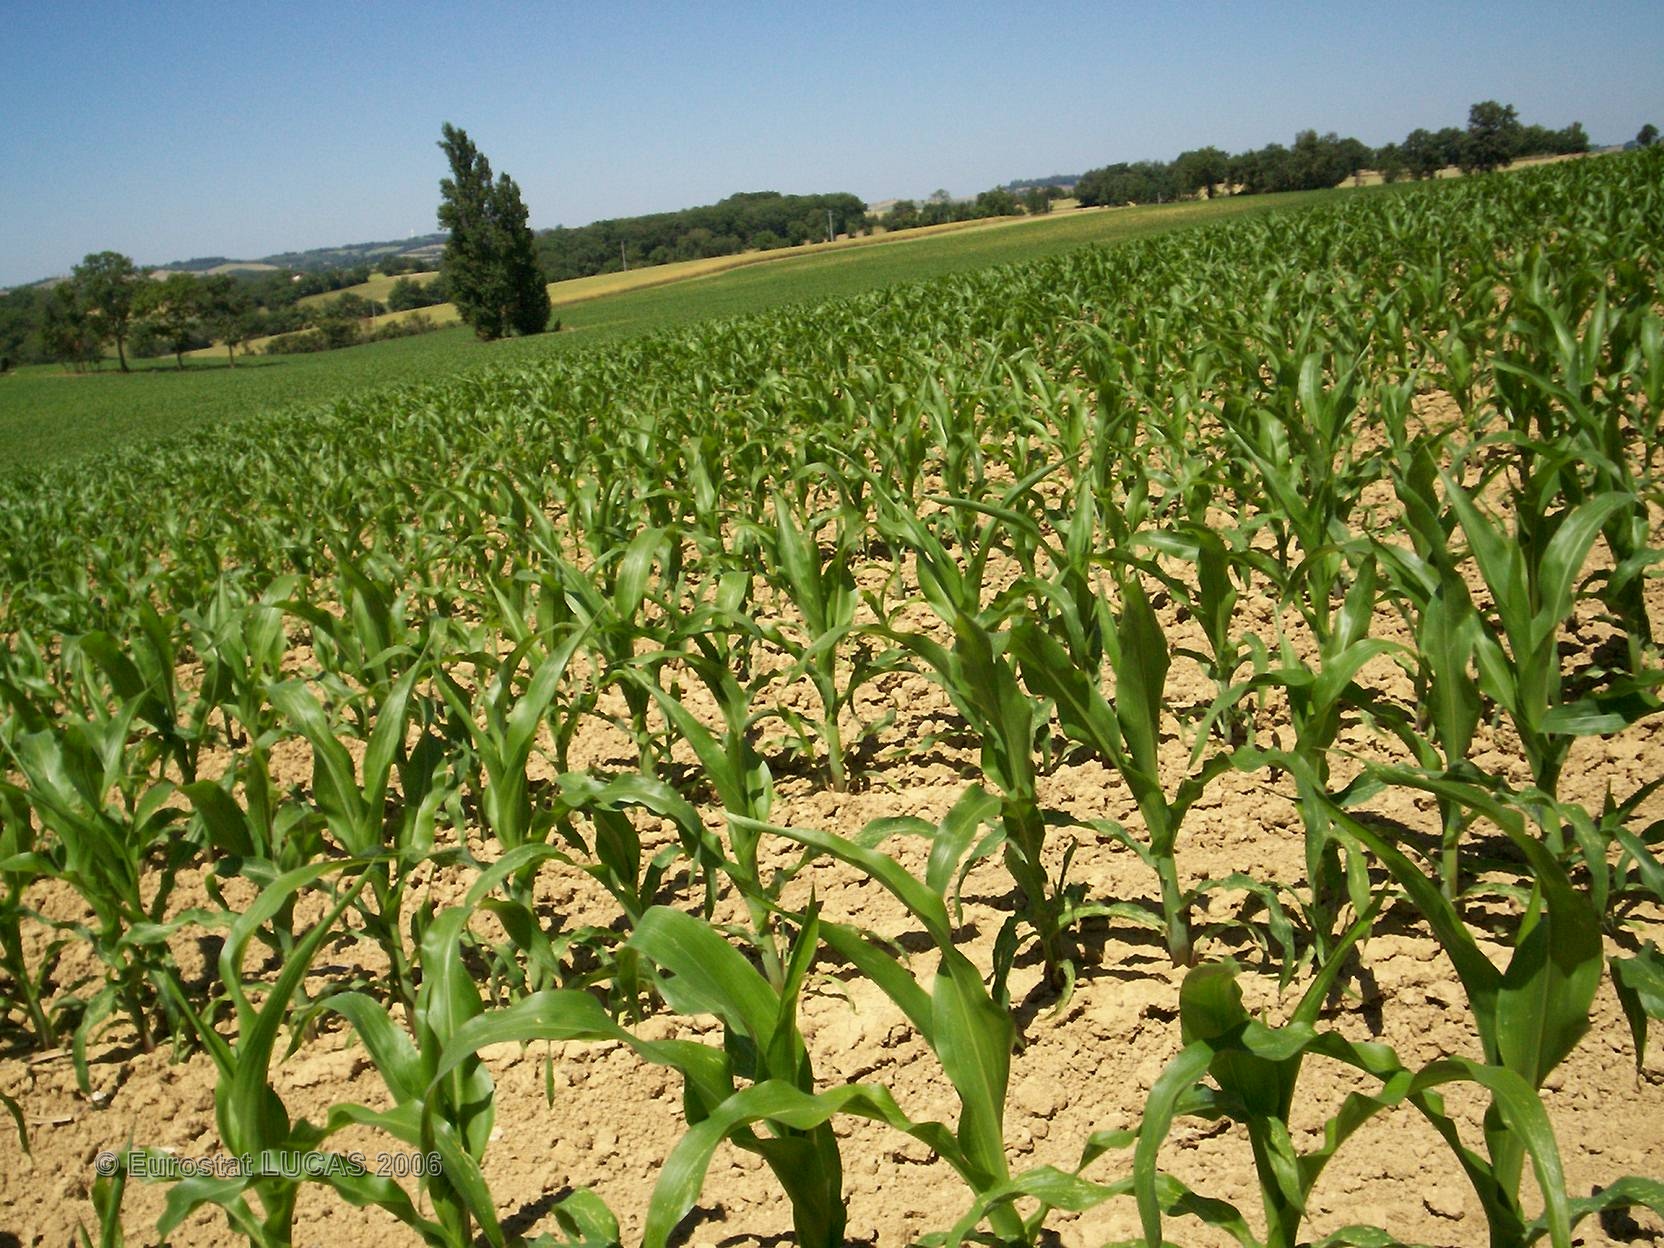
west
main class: Cropland
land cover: Maize
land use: Agriculture (excluding fallow land and kitchen gardens)
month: June
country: FR
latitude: 43.7256
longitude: 0.8249
